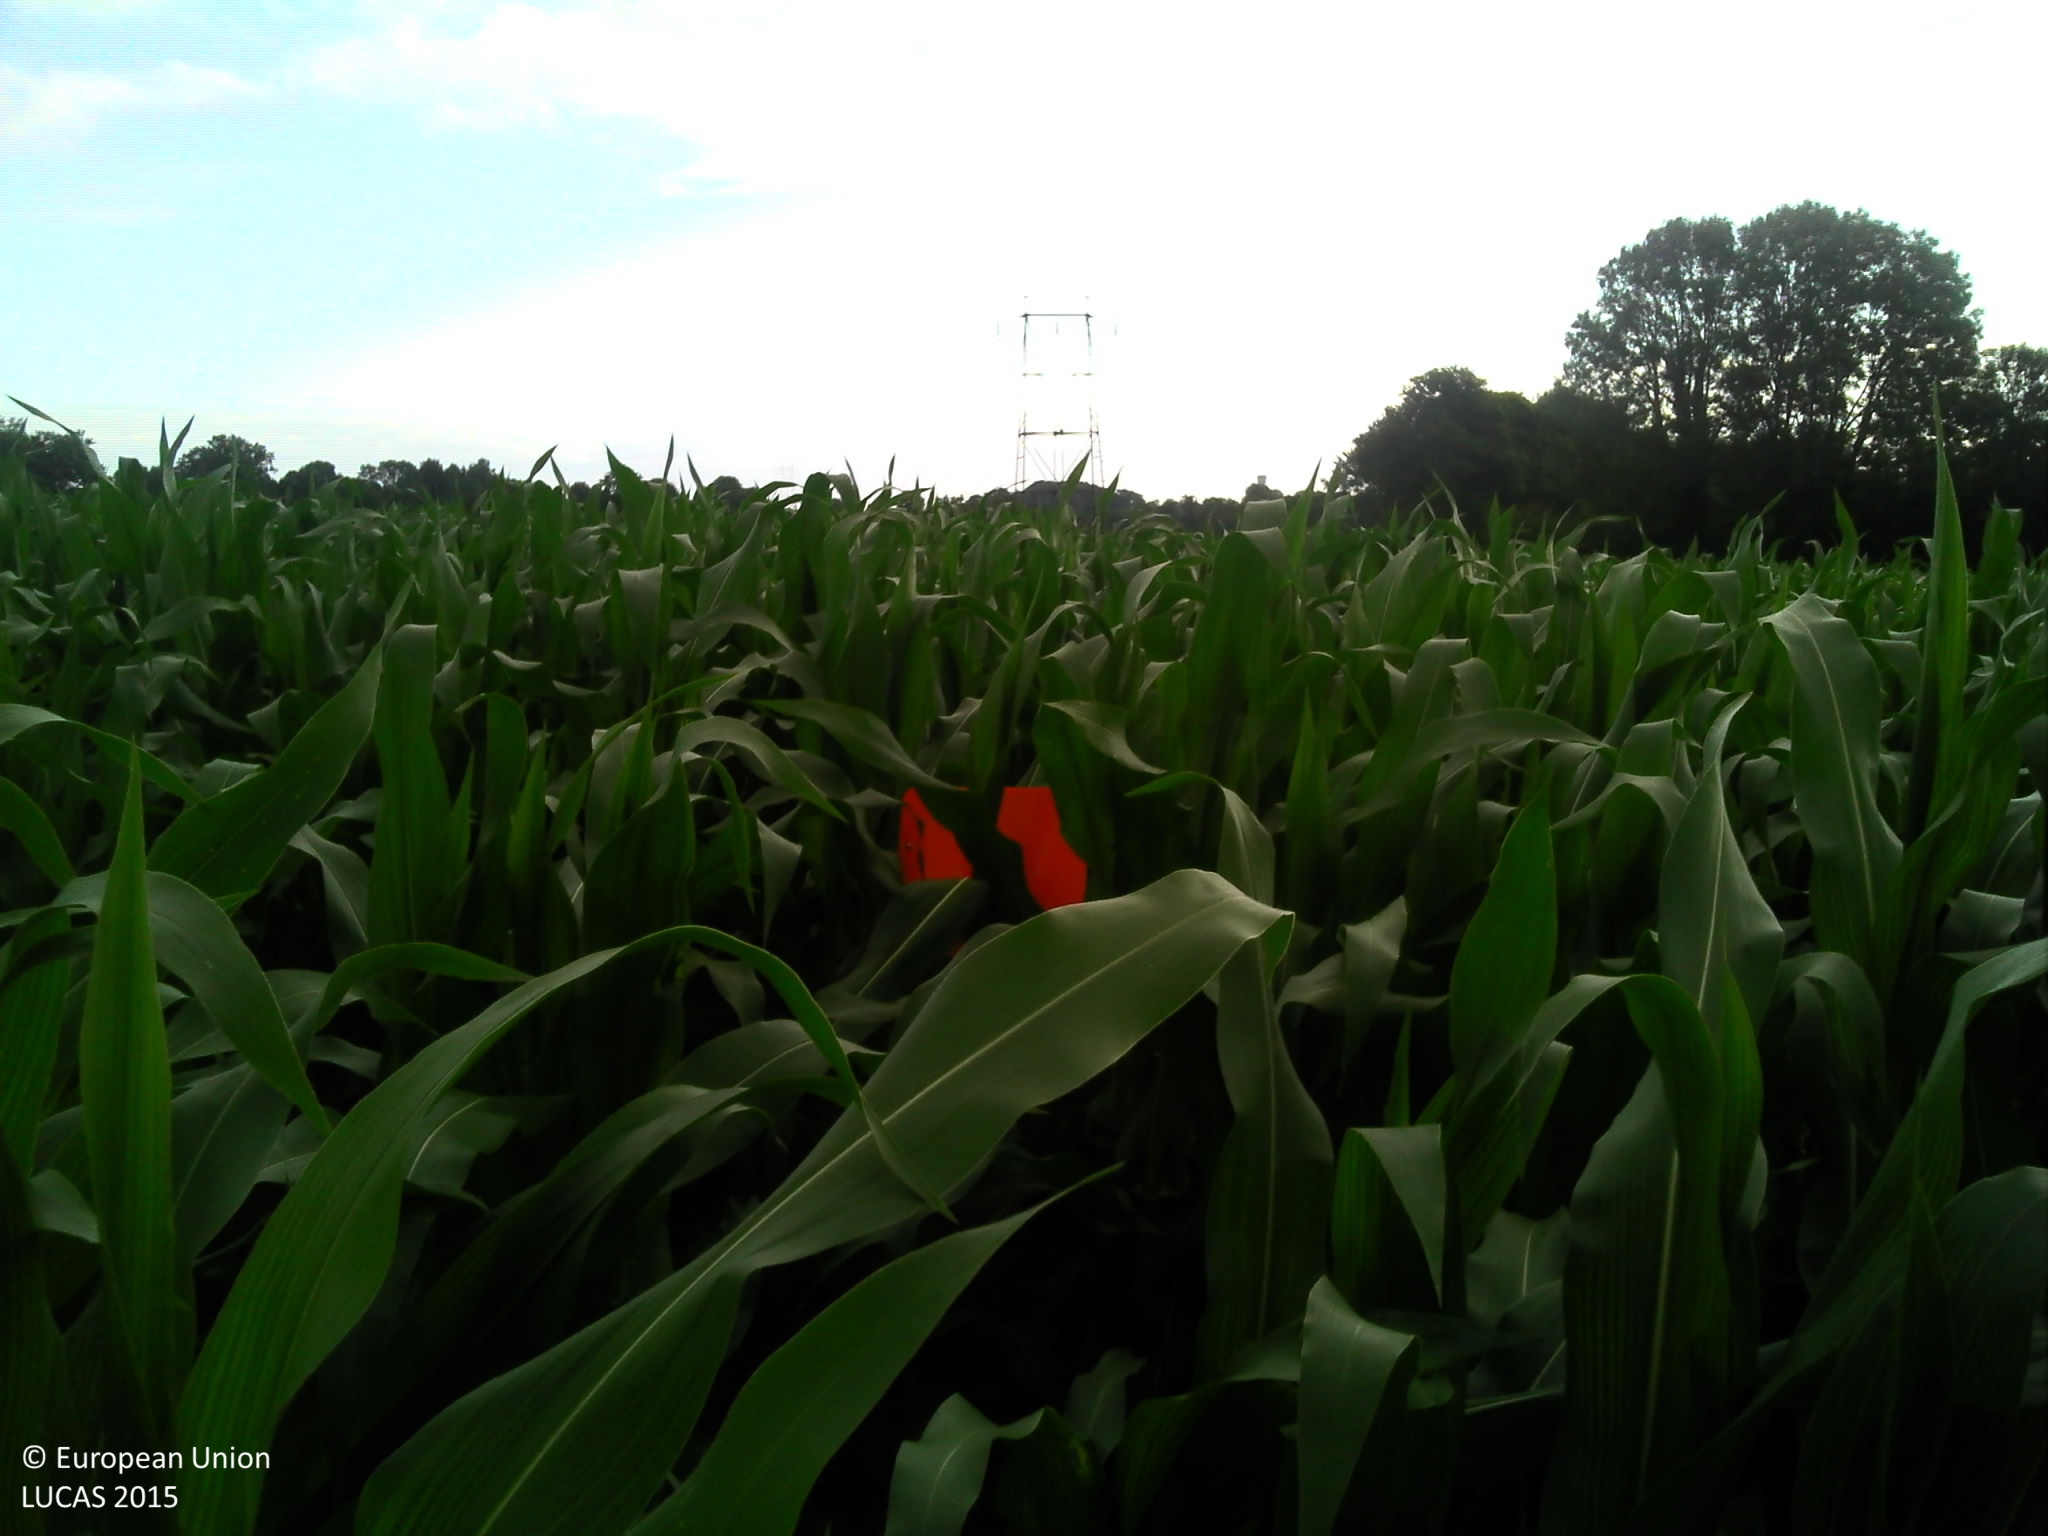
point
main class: Cropland
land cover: Maize
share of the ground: > 75 %
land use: Agriculture (excluding fallow land and kitchen gardens)
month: July
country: FR
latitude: 48.7726
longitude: -1.2429
